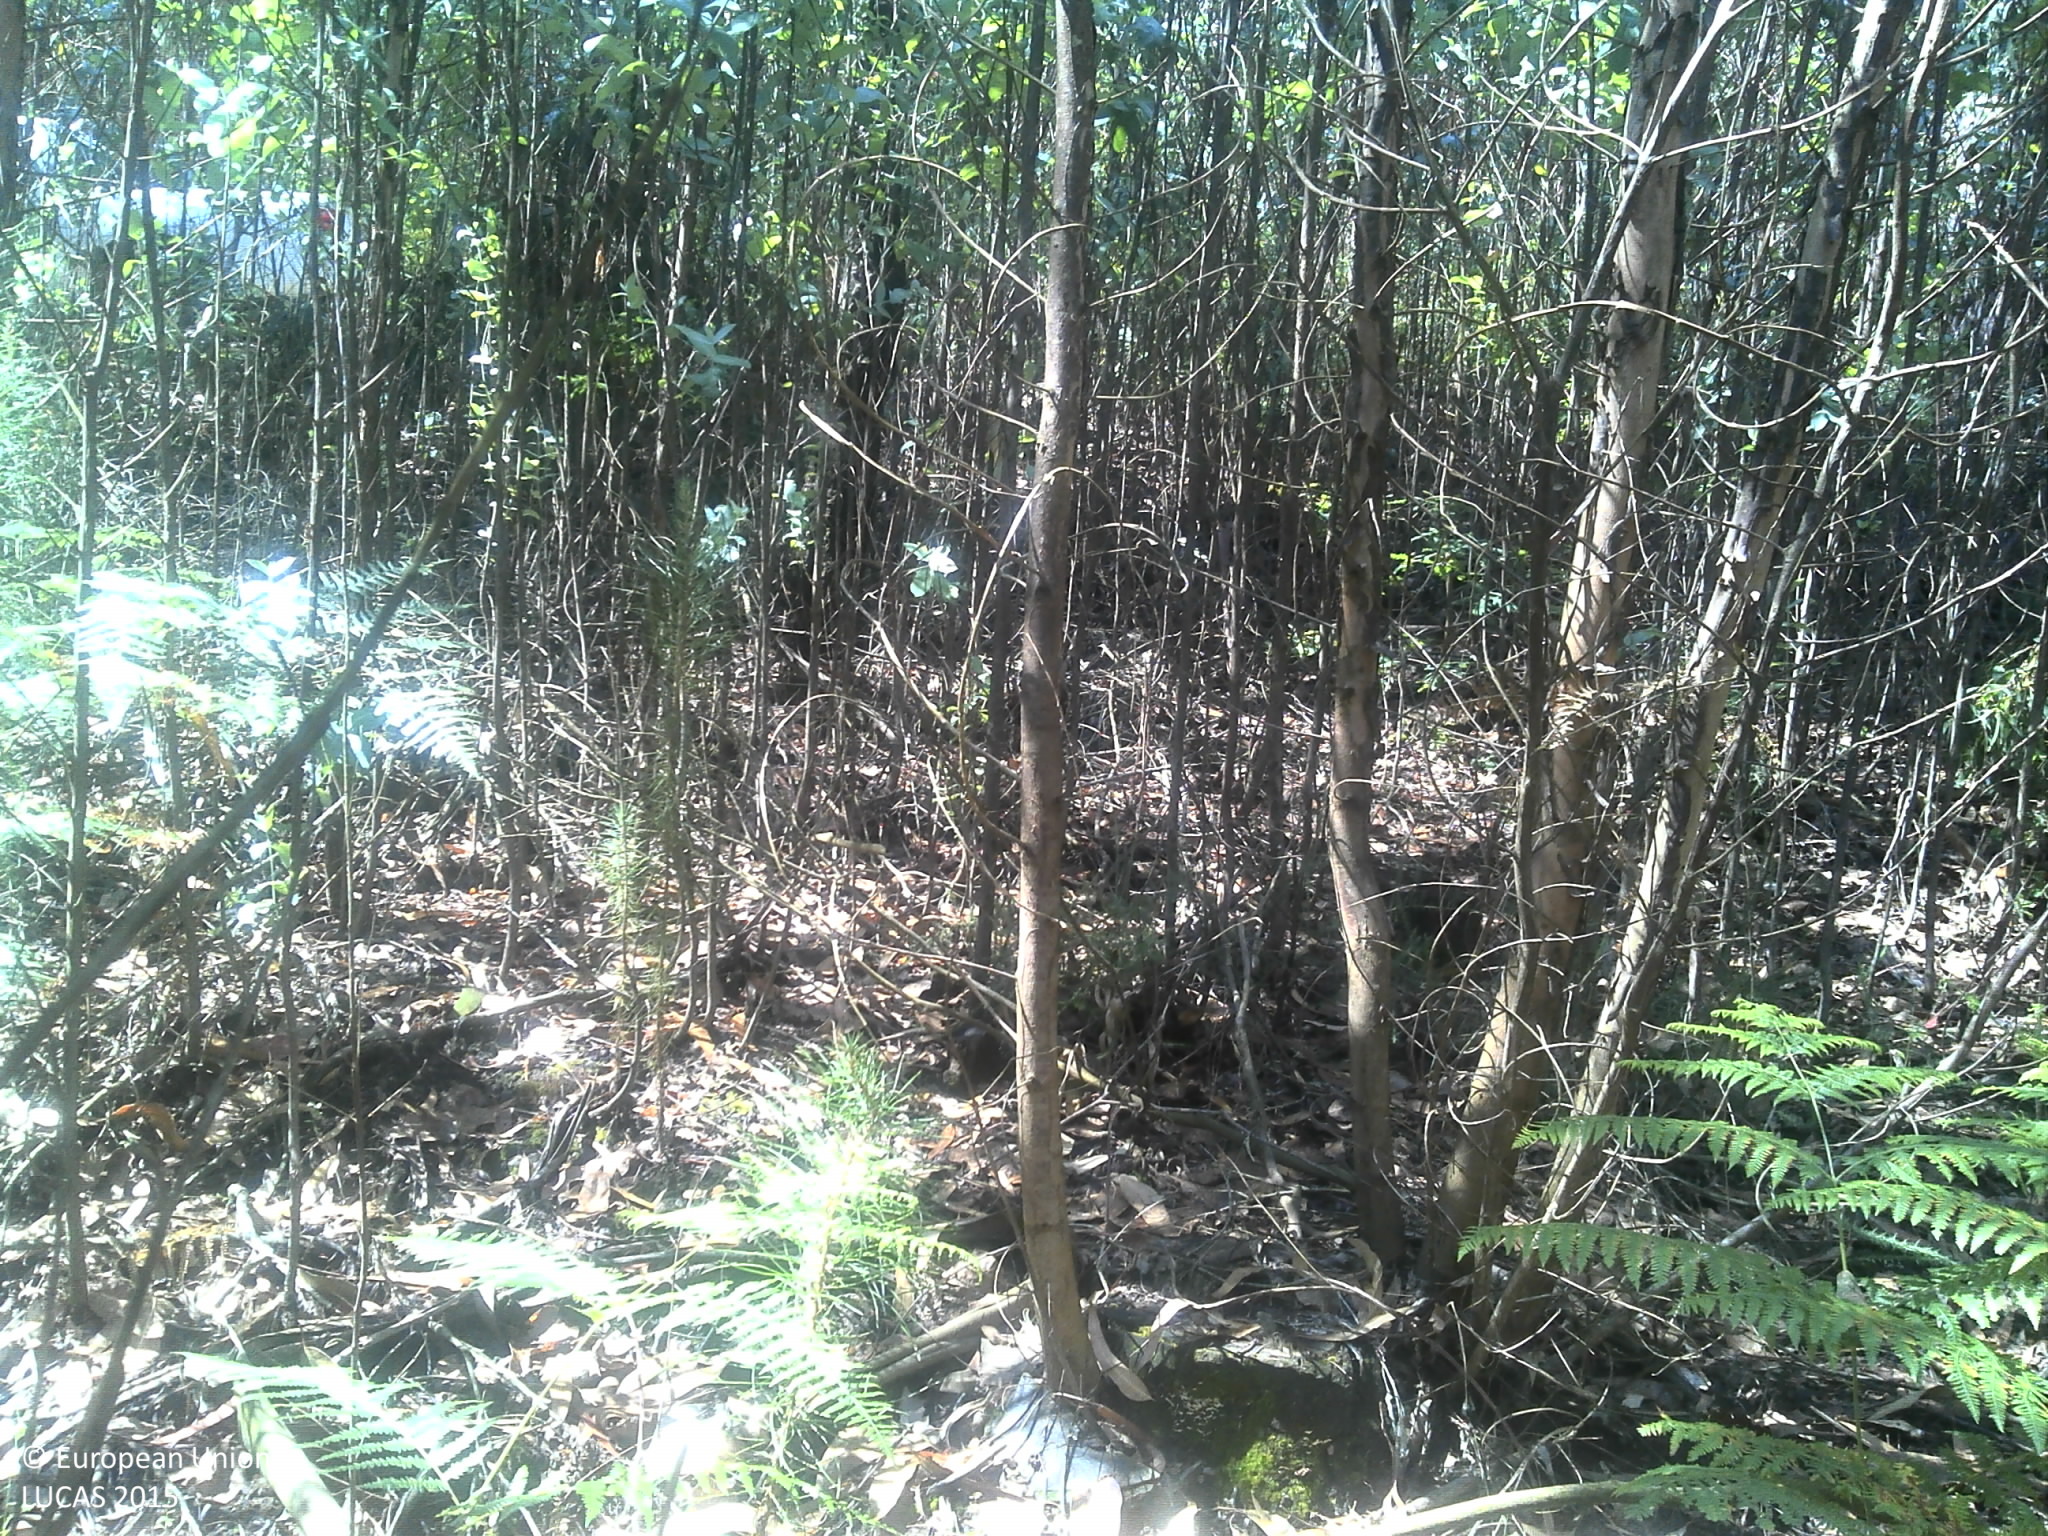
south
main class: Woodland
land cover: Broadleaved woodland
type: exotic forest
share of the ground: > 75 %
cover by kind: broadleaved forest trees 80 %, shrubs 15 %, unconsolidated bare surface 5 %
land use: Forestry
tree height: > 5 m
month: June
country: PT
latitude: 41.6057
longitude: -8.6520
